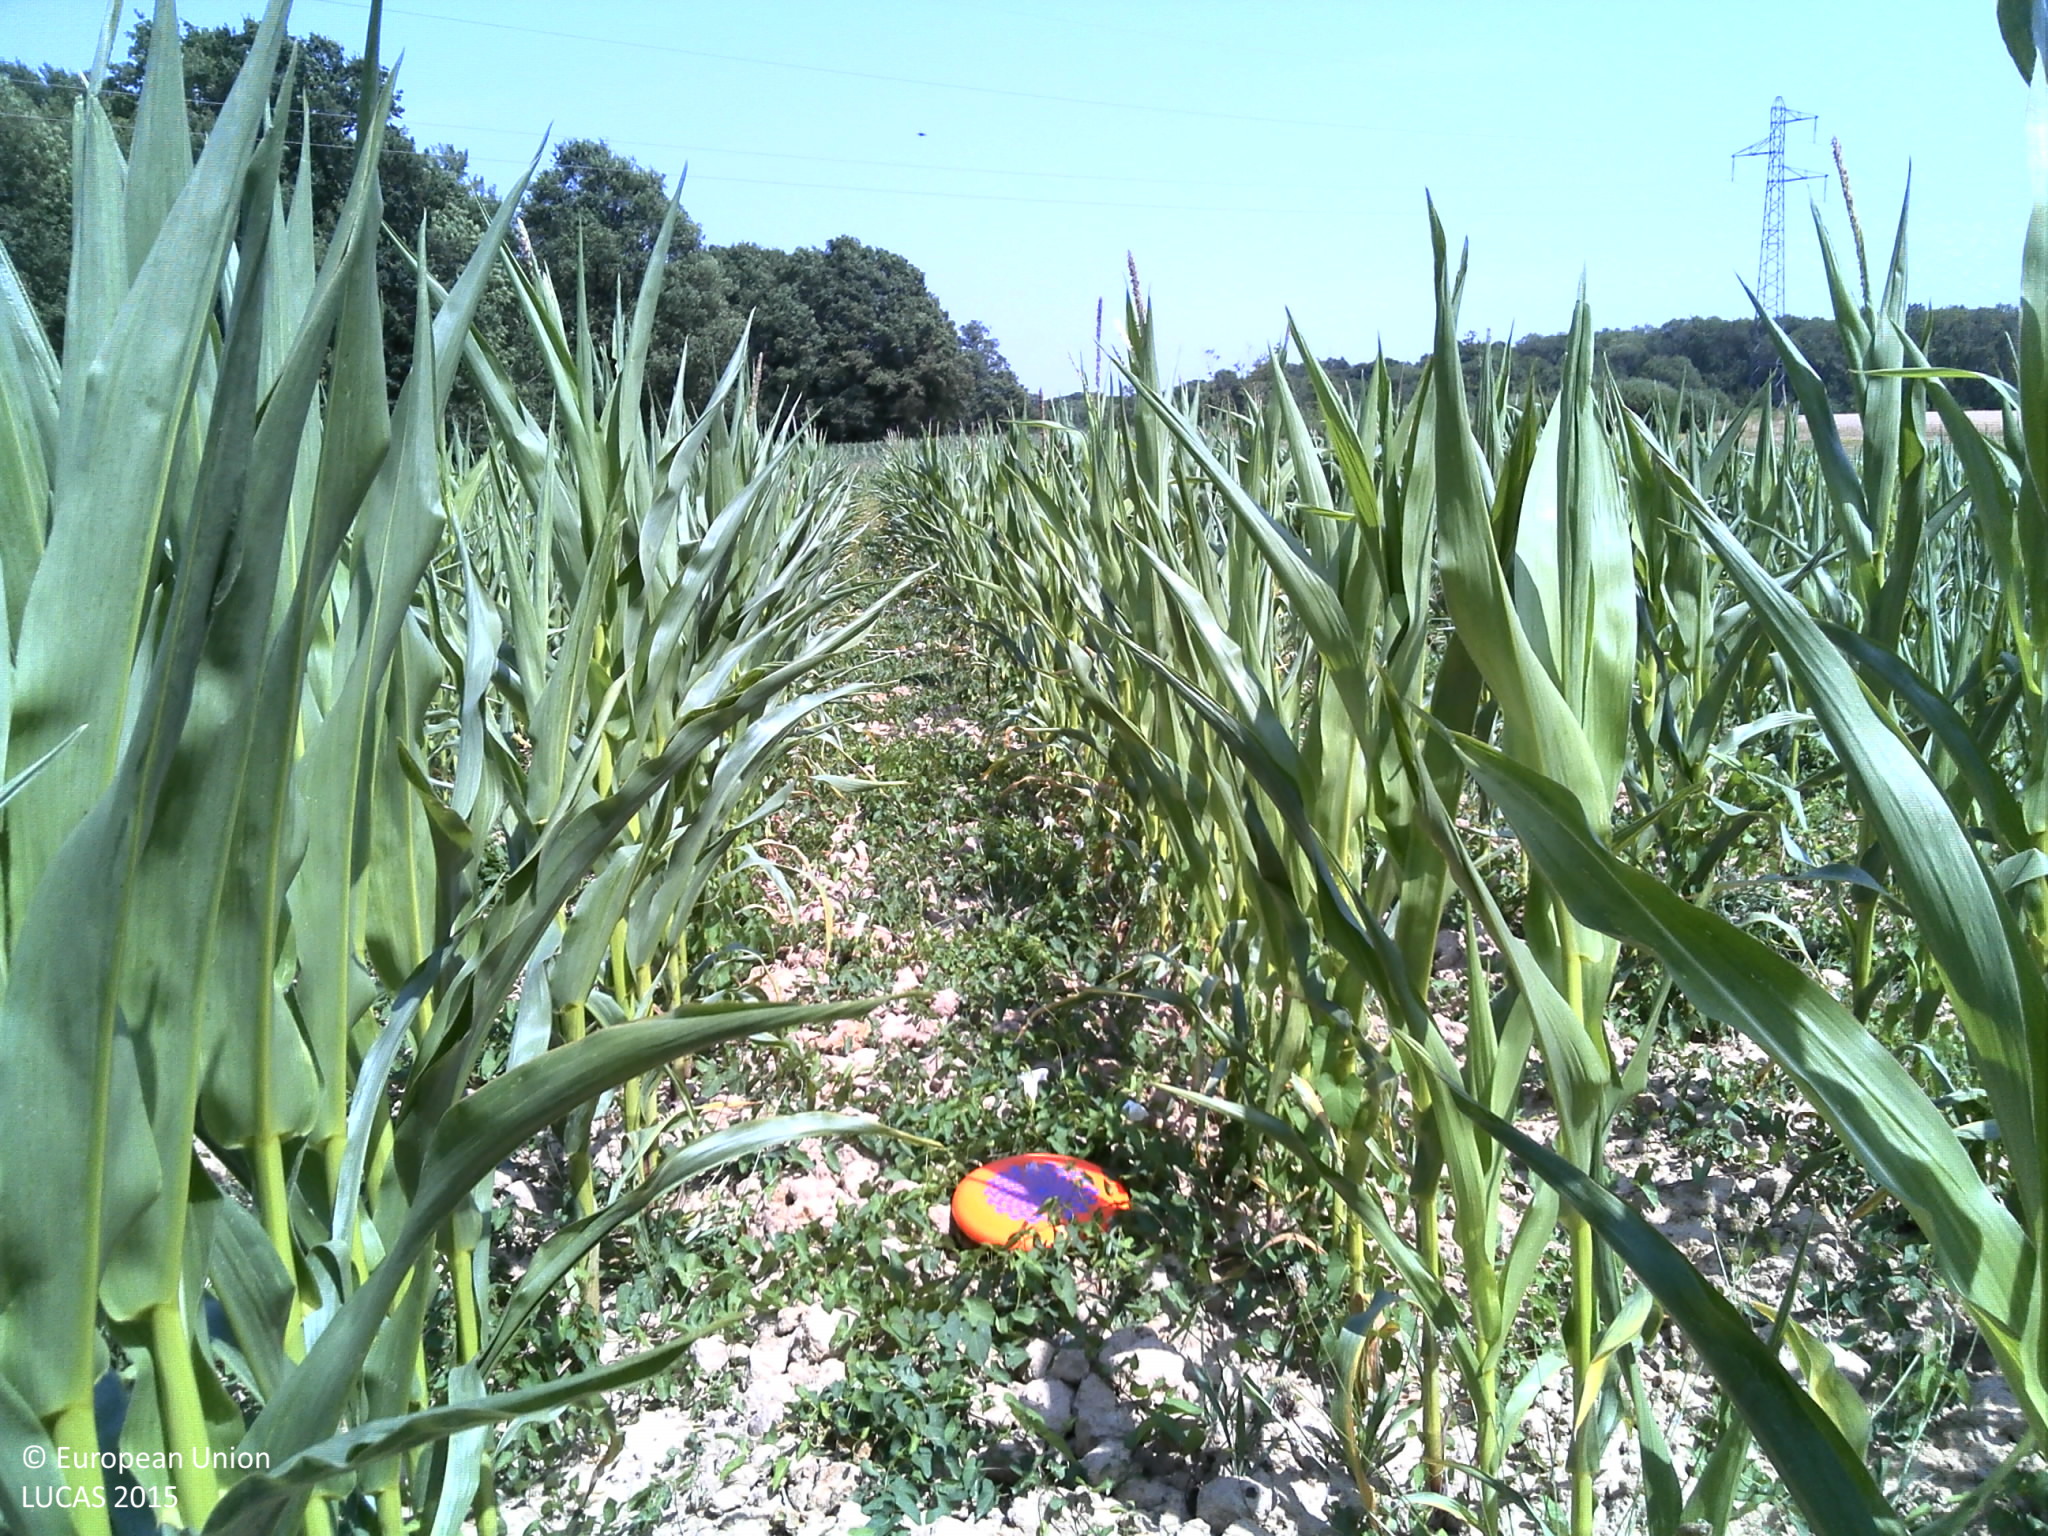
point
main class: Cropland
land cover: Maize
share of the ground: 50 - 75 %
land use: Agriculture (excluding fallow land and kitchen gardens)
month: July
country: FR
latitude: 48.8633
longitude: 4.9133
